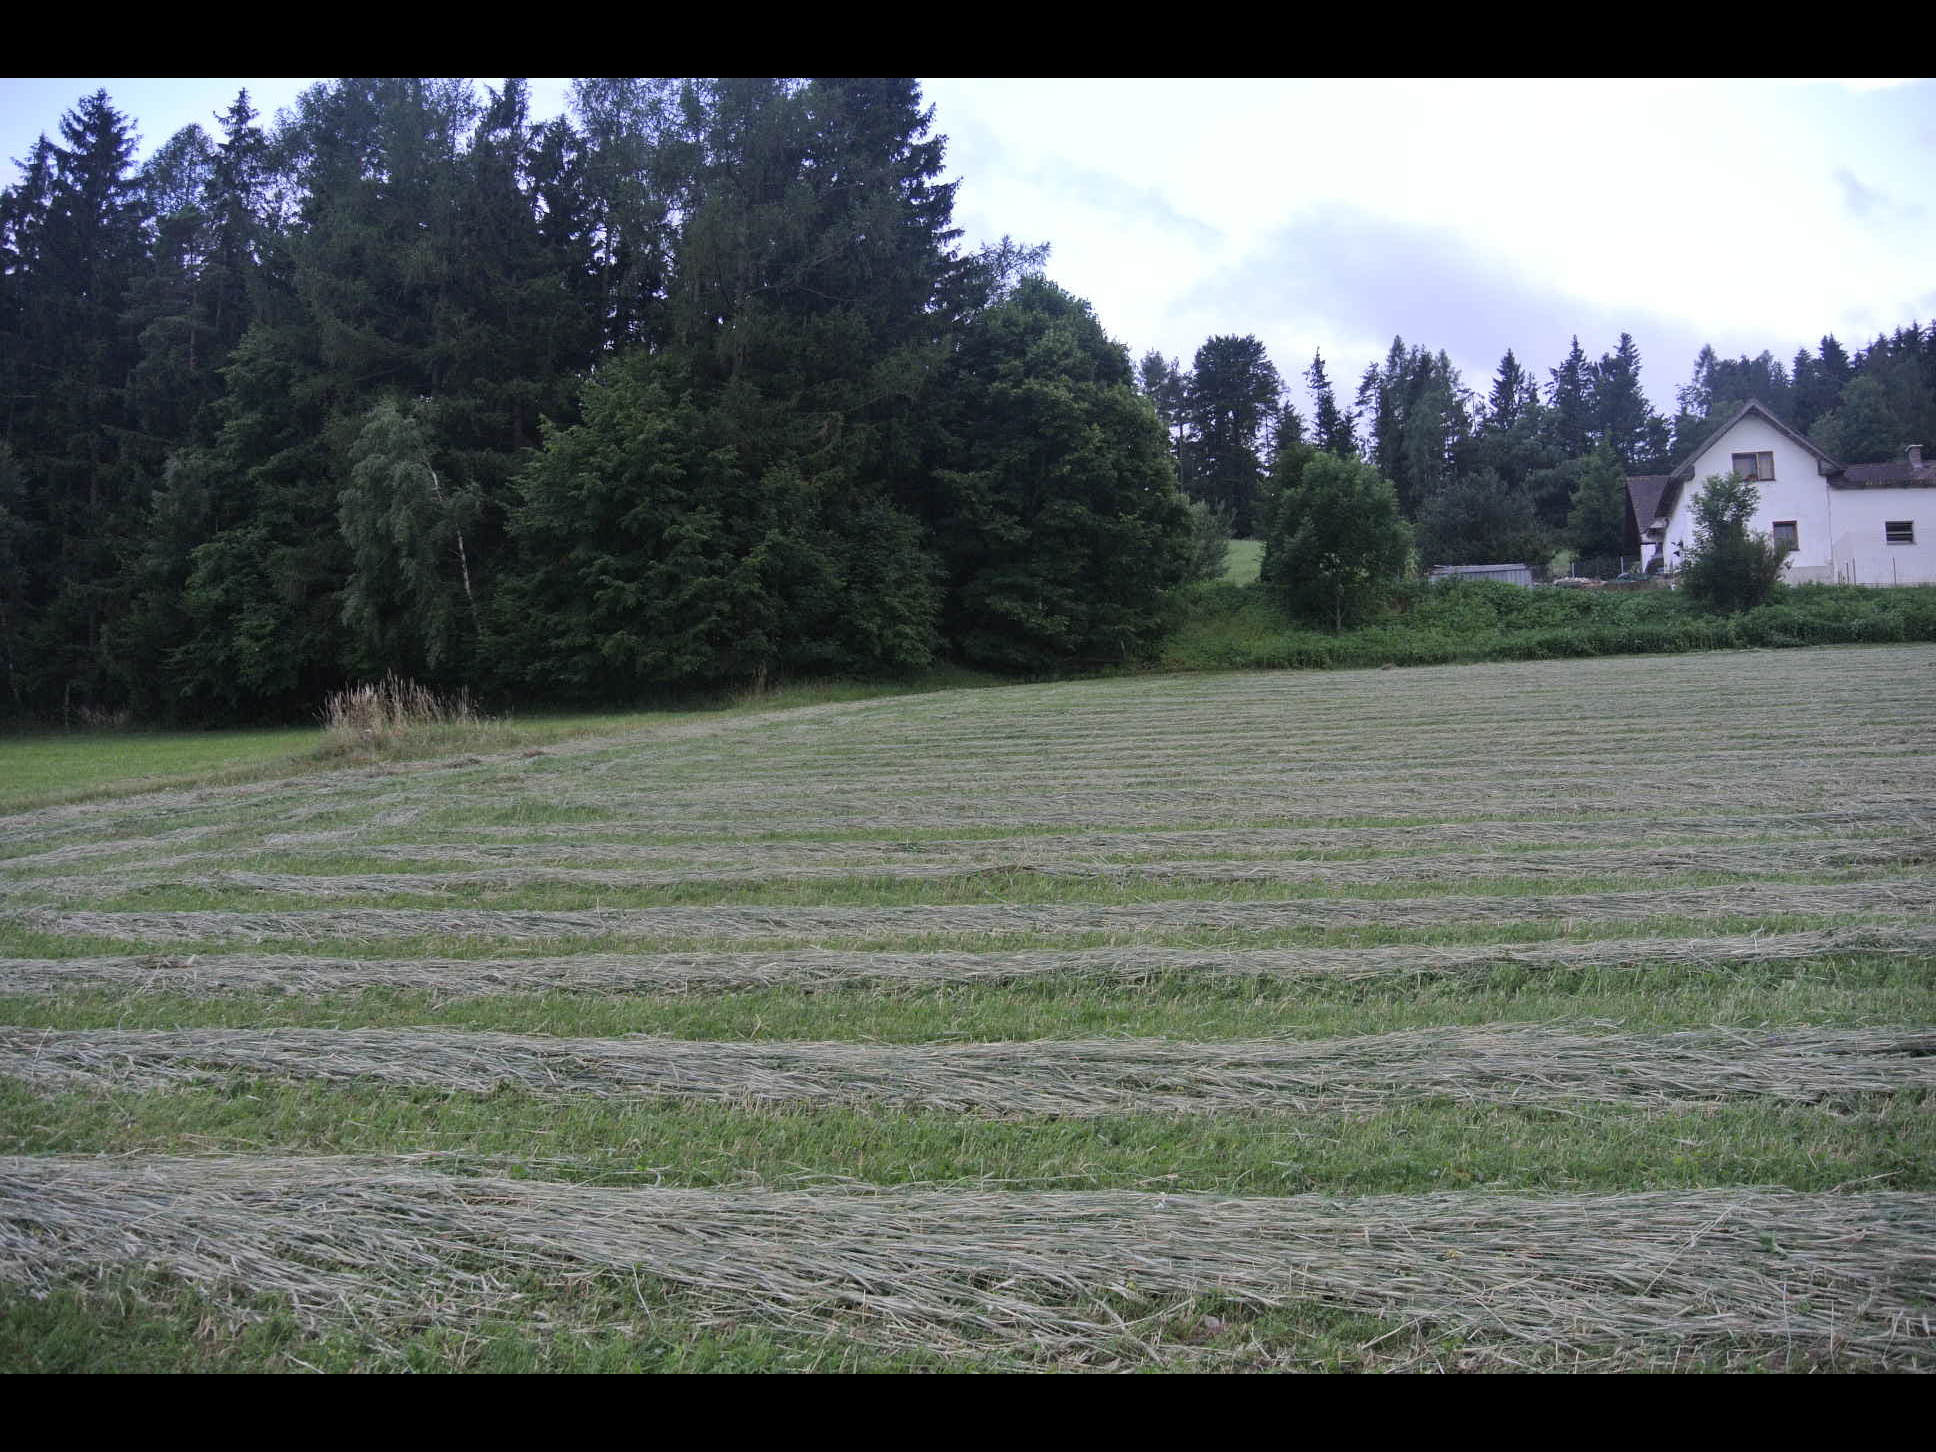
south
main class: Cropland
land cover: Rye
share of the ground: > 75 %
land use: Agriculture (excluding fallow land and kitchen gardens)
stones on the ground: < 10 %
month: July
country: AT
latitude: 47.5313
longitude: 16.0995
